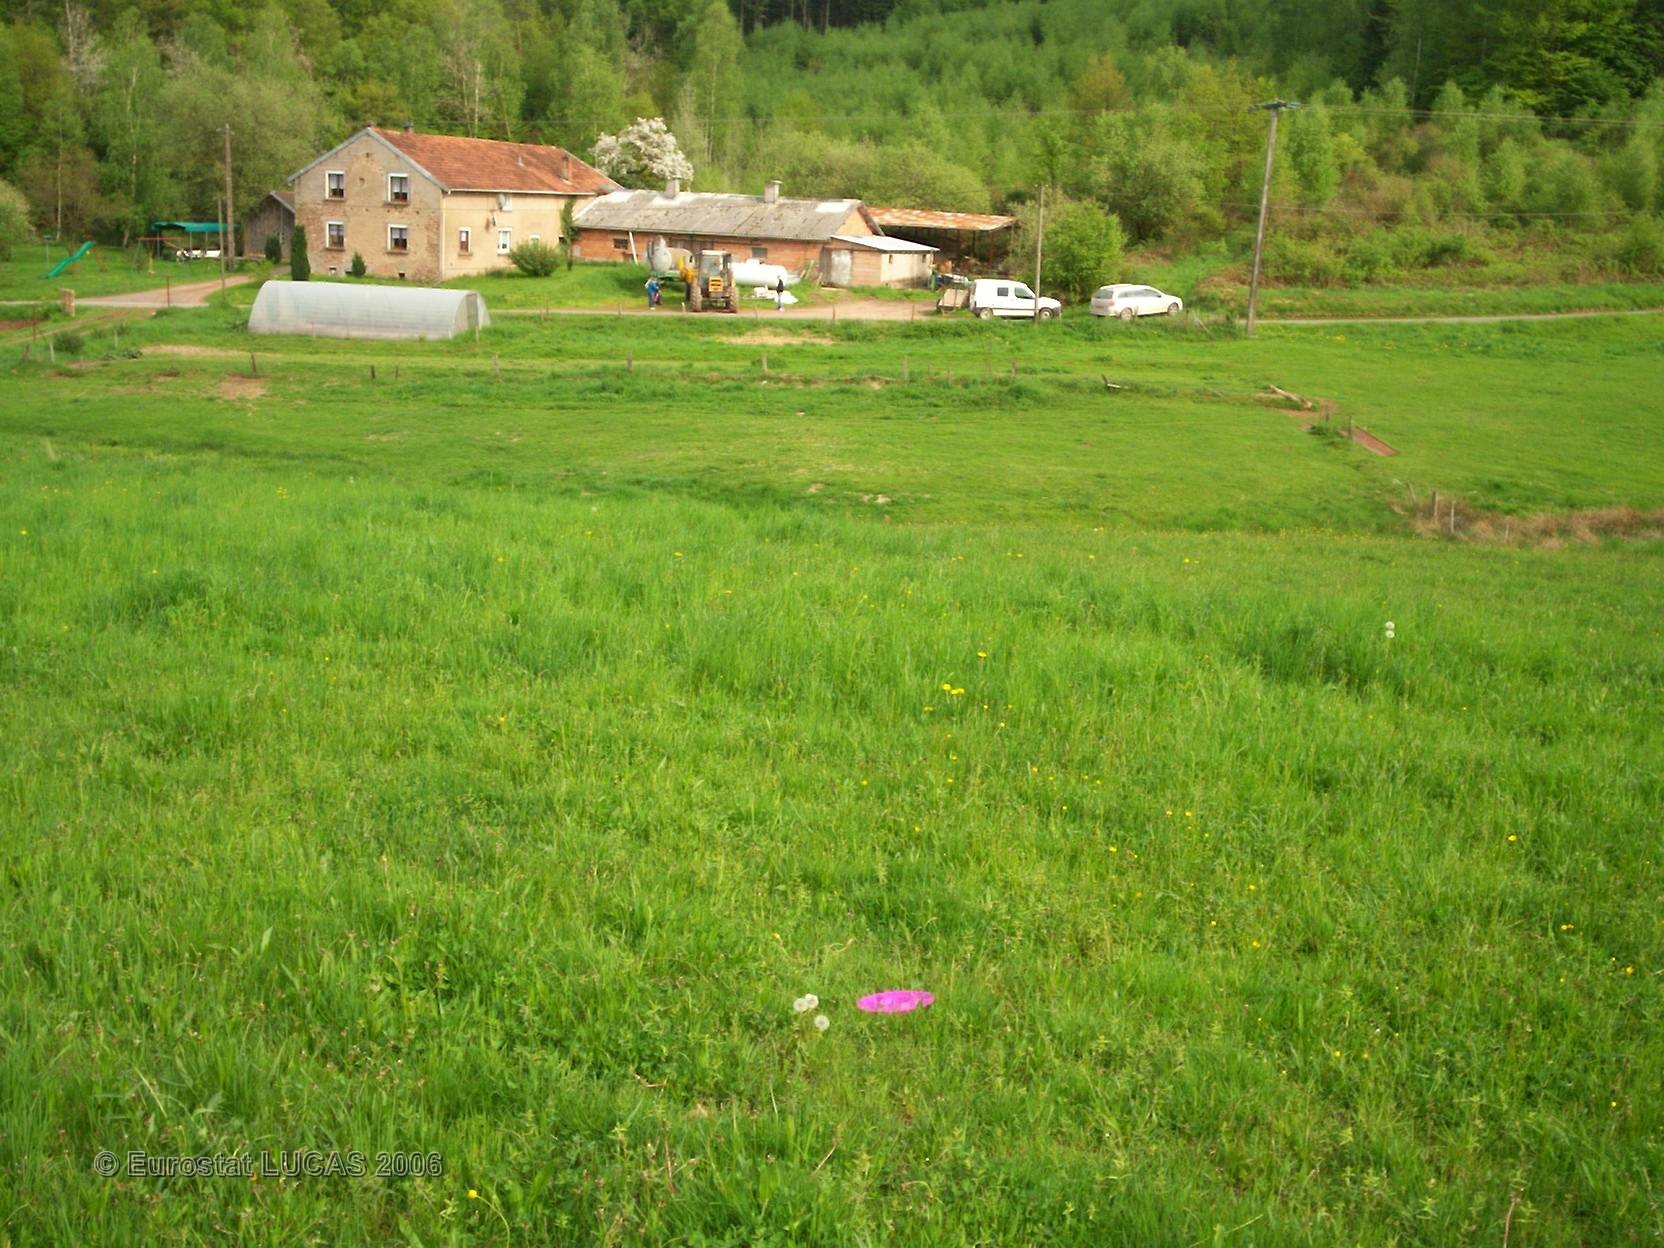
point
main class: Grassland
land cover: Grassland without tree/shrub cover
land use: Agriculture (excluding fallow land and kitchen gardens)
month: May
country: FR
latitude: 48.5970
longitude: 7.0040
